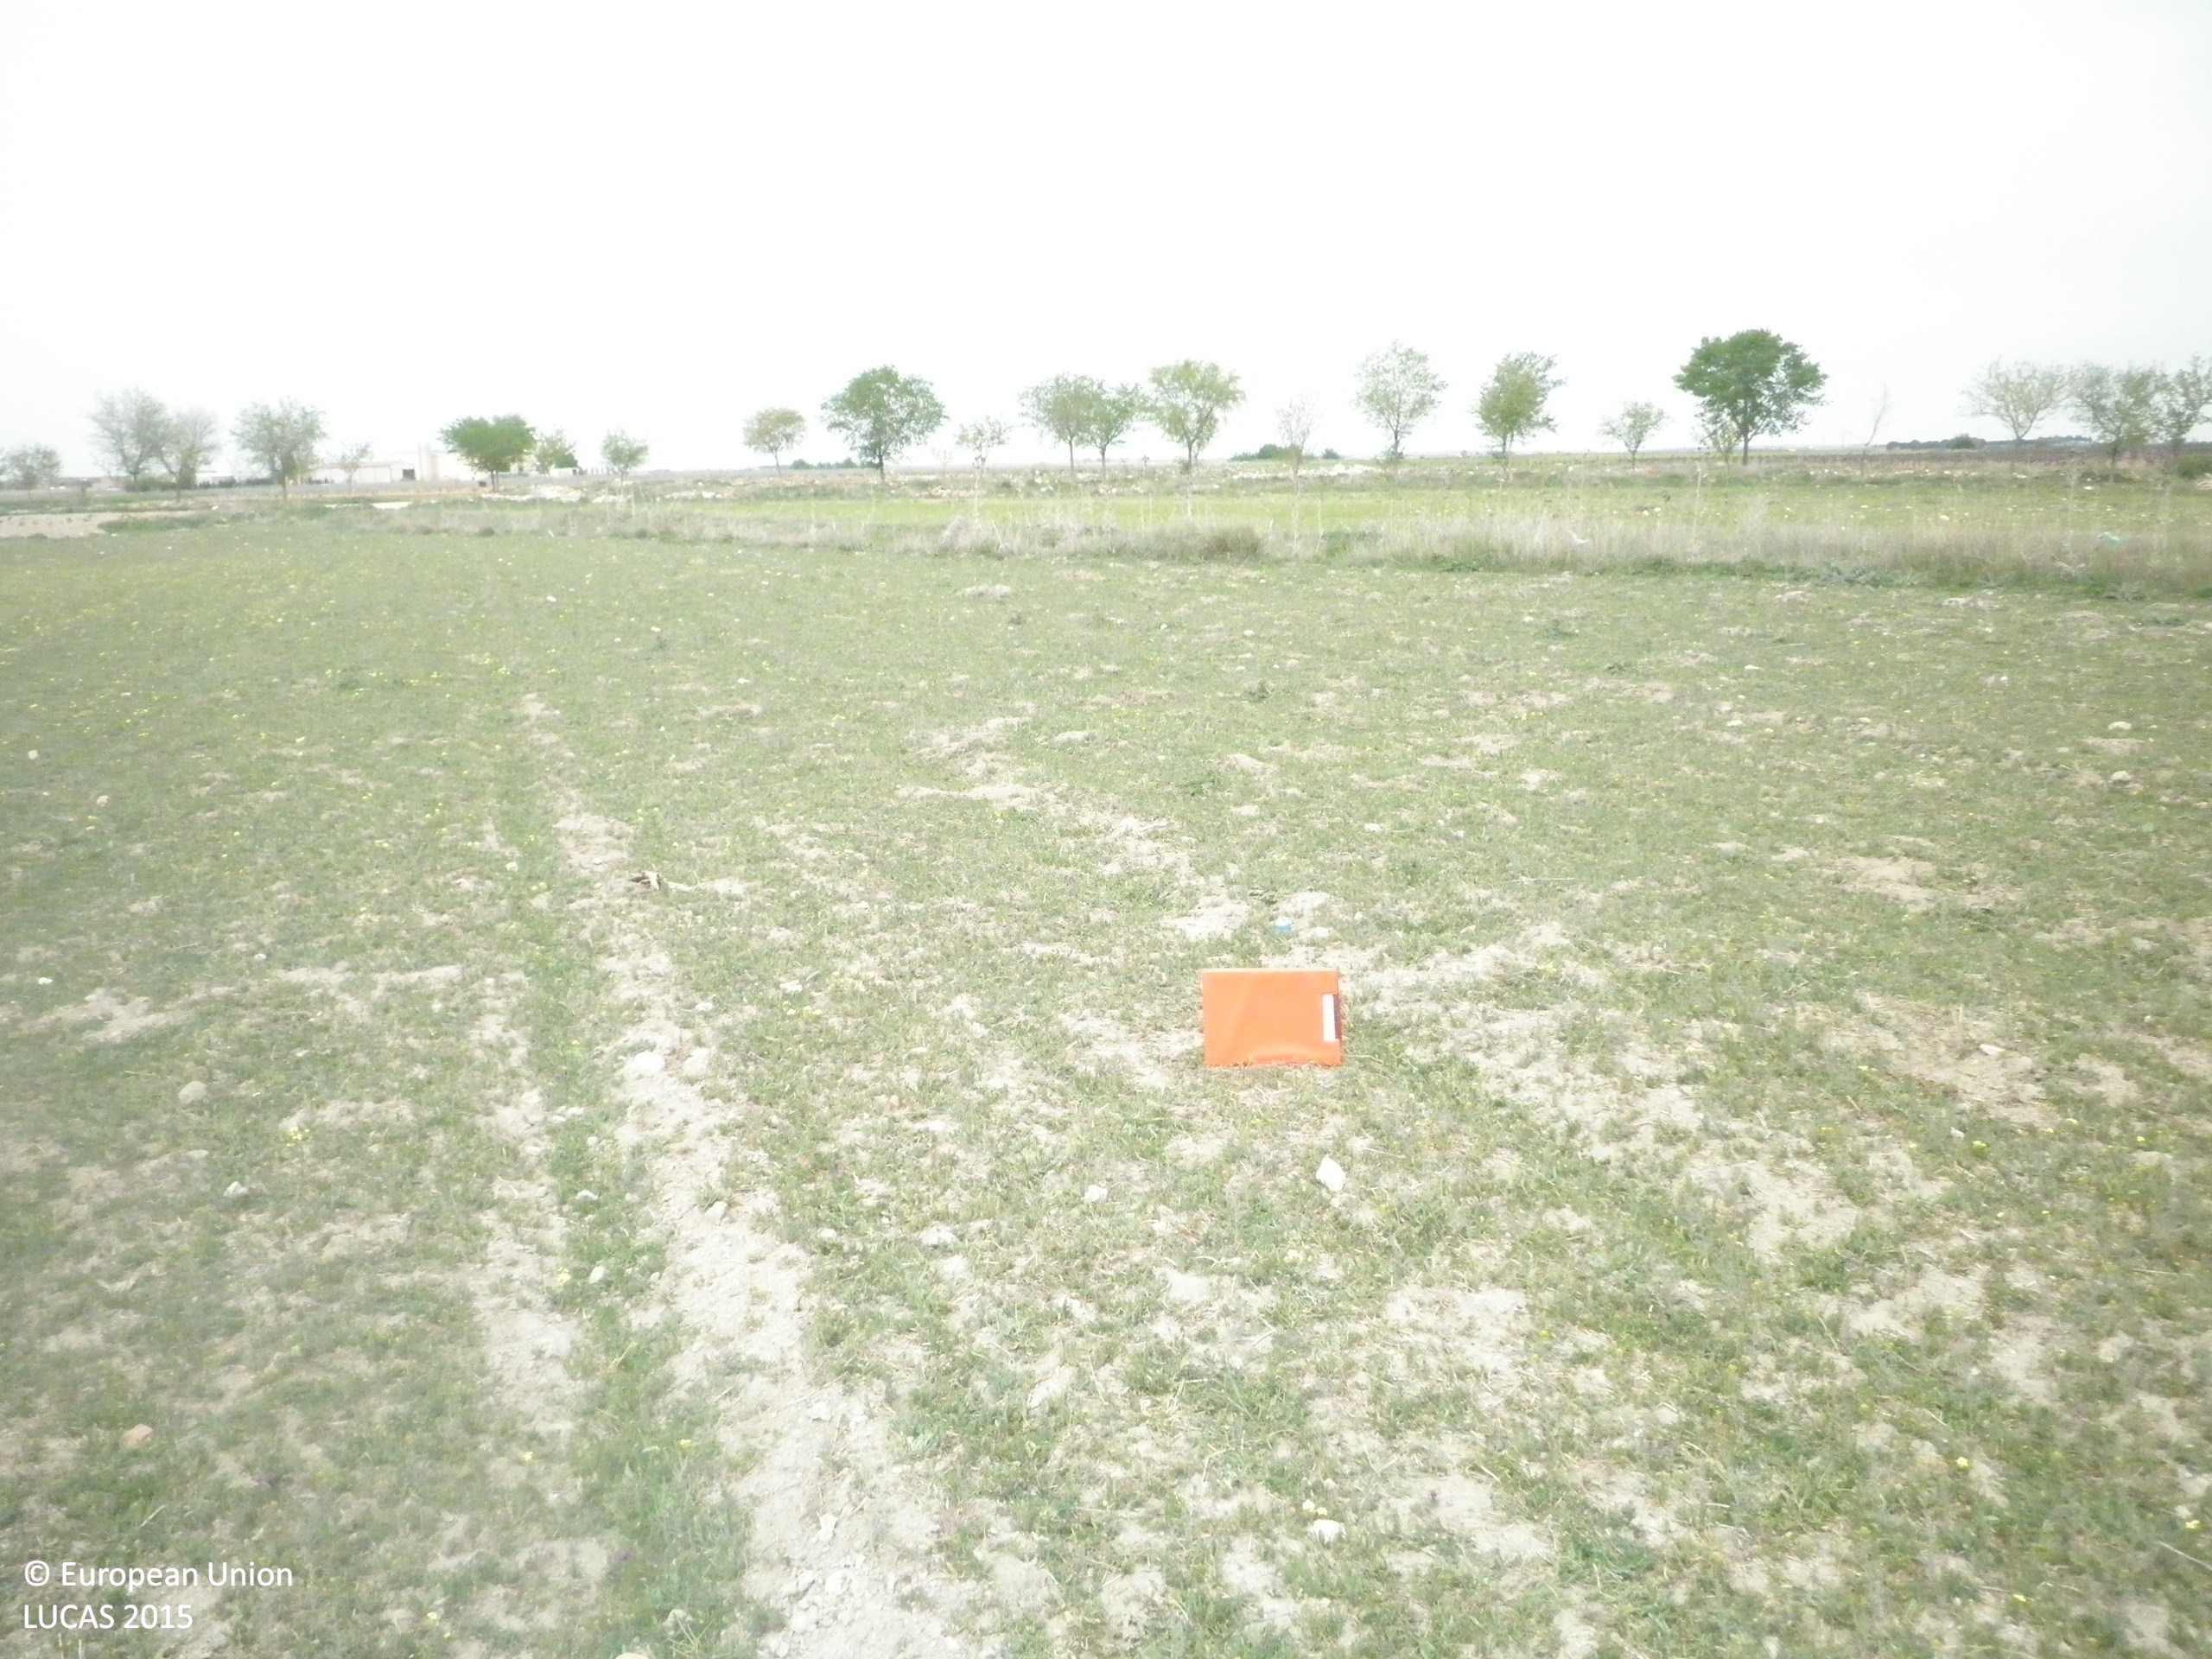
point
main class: Grassland
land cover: Grassland without tree/shrub cover
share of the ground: 50 - 75 %
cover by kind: herbaceous plants 60 %, unconsolidated bare surface 40 %
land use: Agriculture (excluding fallow land and kitchen gardens)
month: April
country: ES
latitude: 39.3950
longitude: -2.7510
